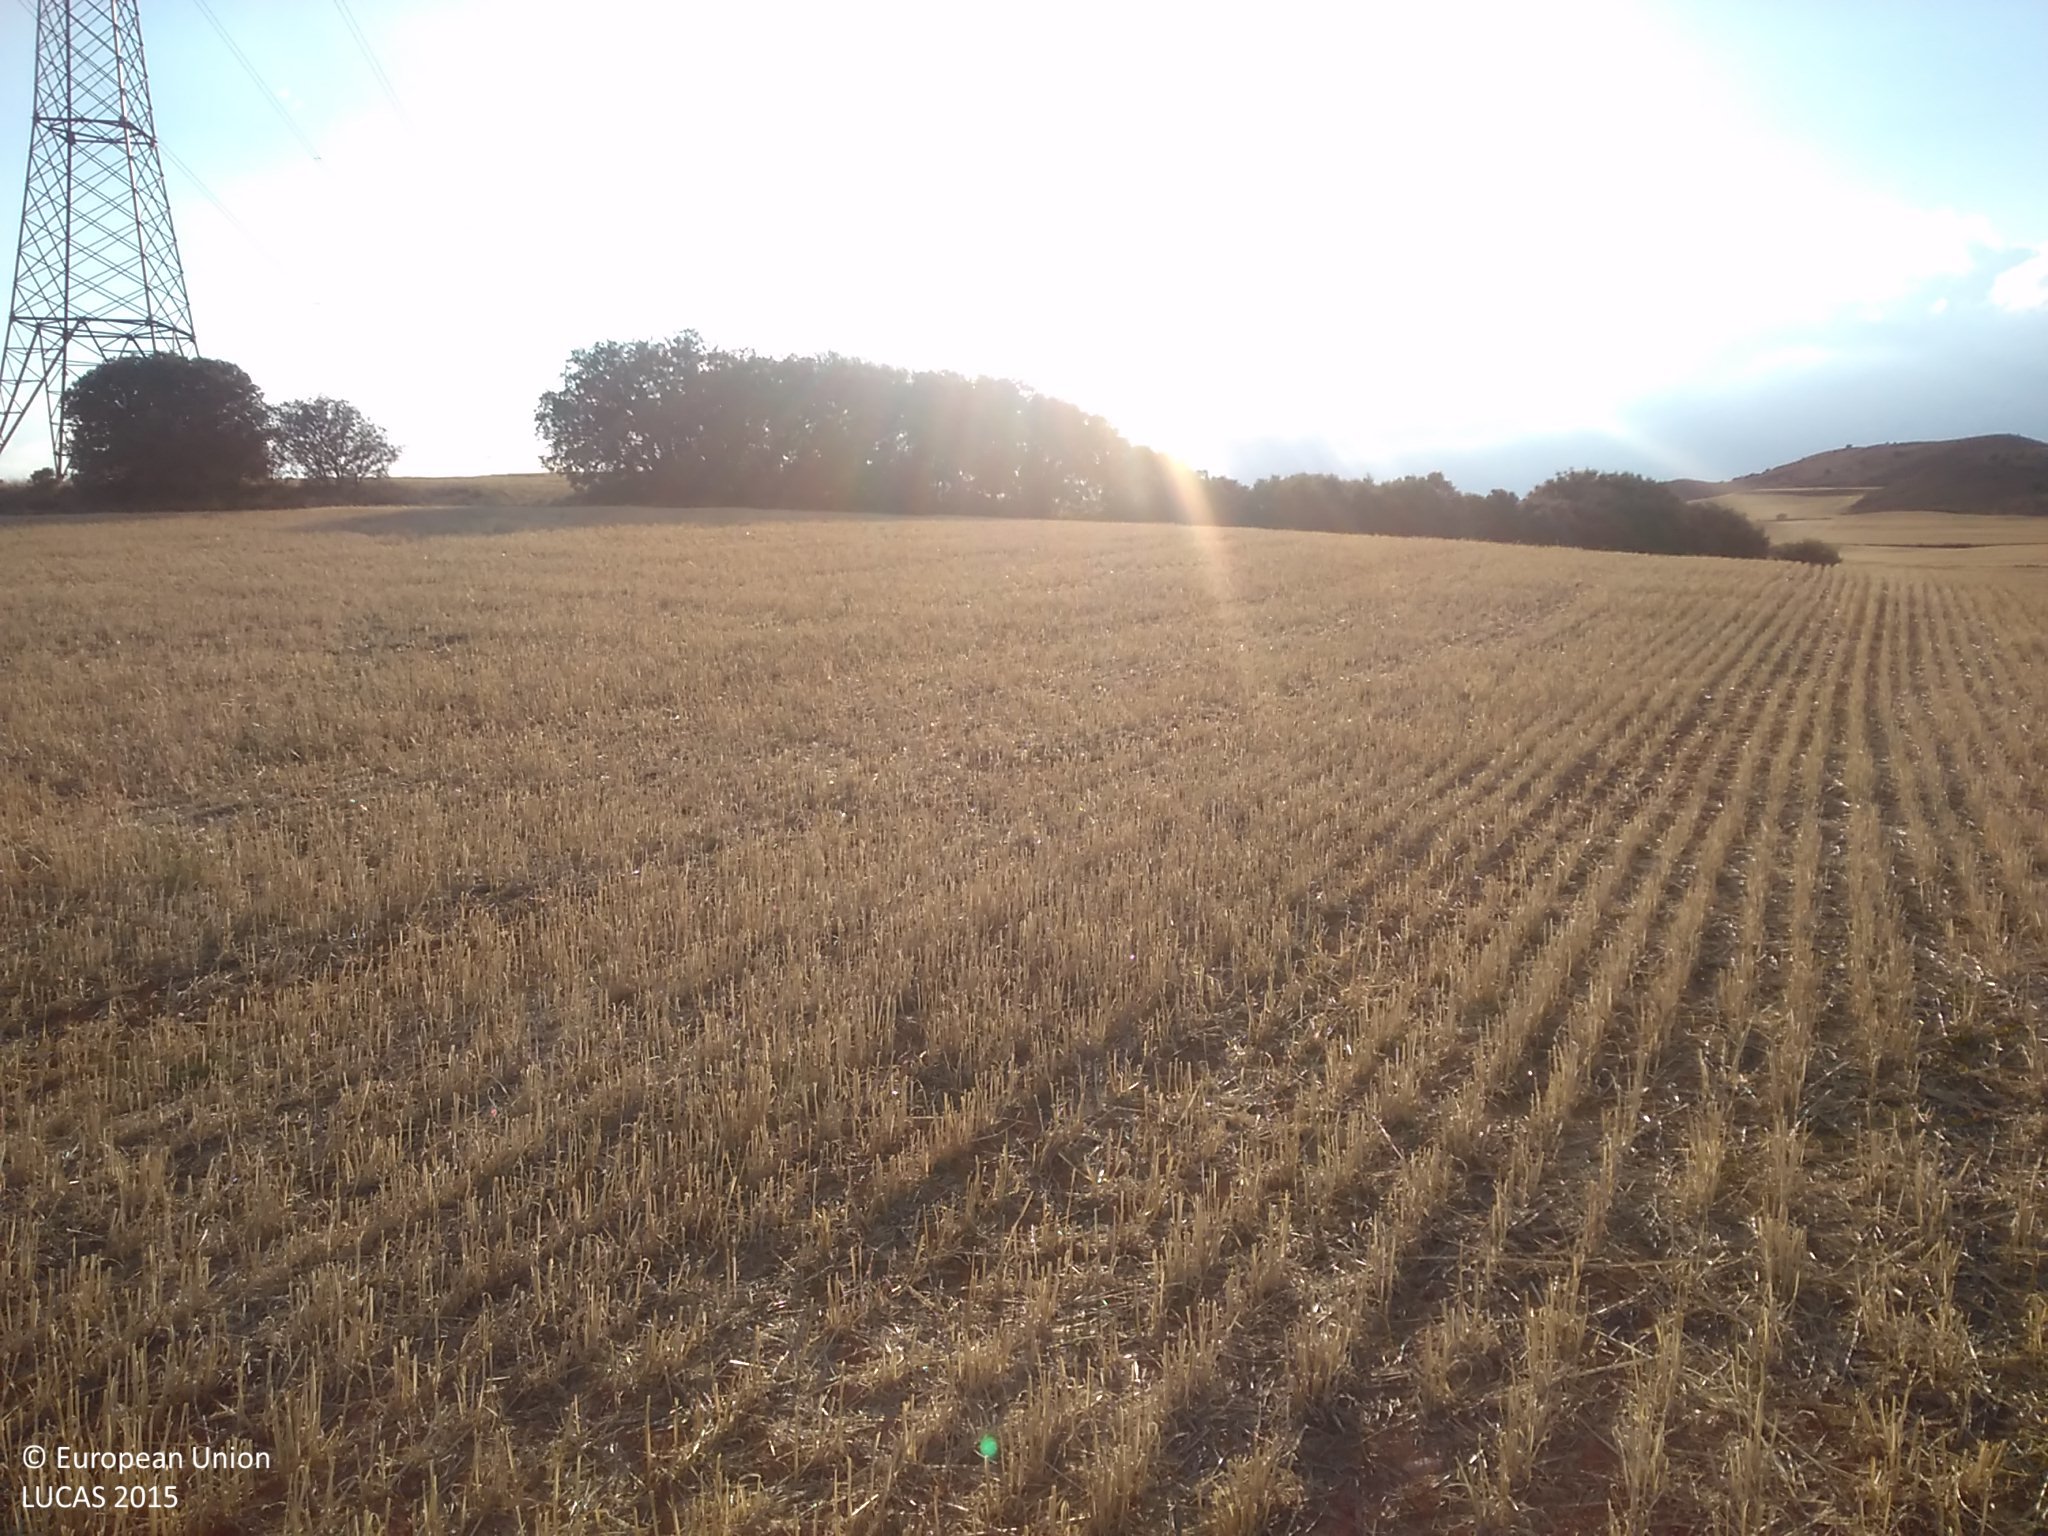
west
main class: Cropland
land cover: Barley
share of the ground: < 10 %
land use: Agriculture (excluding fallow land and kitchen gardens)
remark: Harvested field
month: July
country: ES
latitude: 41.4179
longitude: -2.2233
